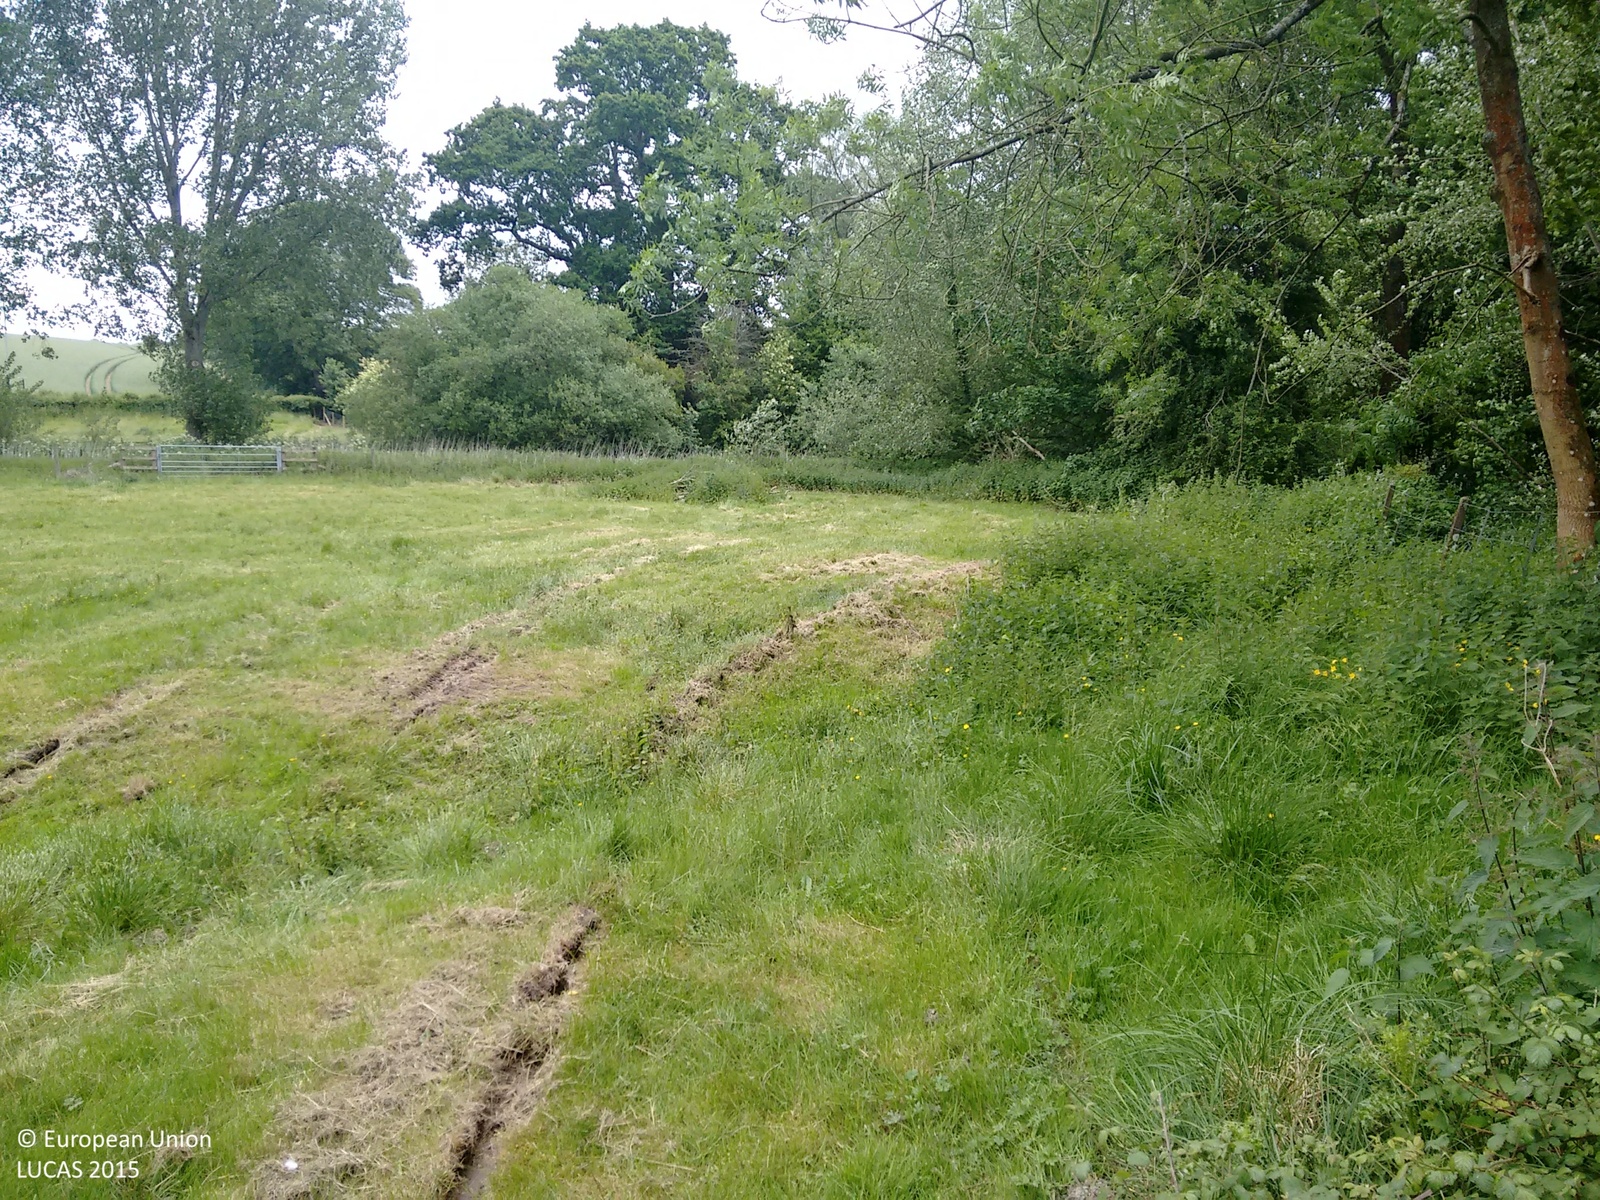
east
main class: Grassland
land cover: Grassland without tree/shrub cover
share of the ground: > 75 %
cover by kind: herbaceous plants 100 %
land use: Agriculture (excluding fallow land and kitchen gardens)
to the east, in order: Grassland without tree/shrub cover; Fences; Spontaneously vegetated surfaces; Inland fresh running water; Managed hedges; Broadleaved woodland; Fences; Managed hedges; Paved roads, cycling and walking lanes; Managed hedges; Grass margins; Common wheat
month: June
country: GB
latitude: 51.0893
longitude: -1.8636
